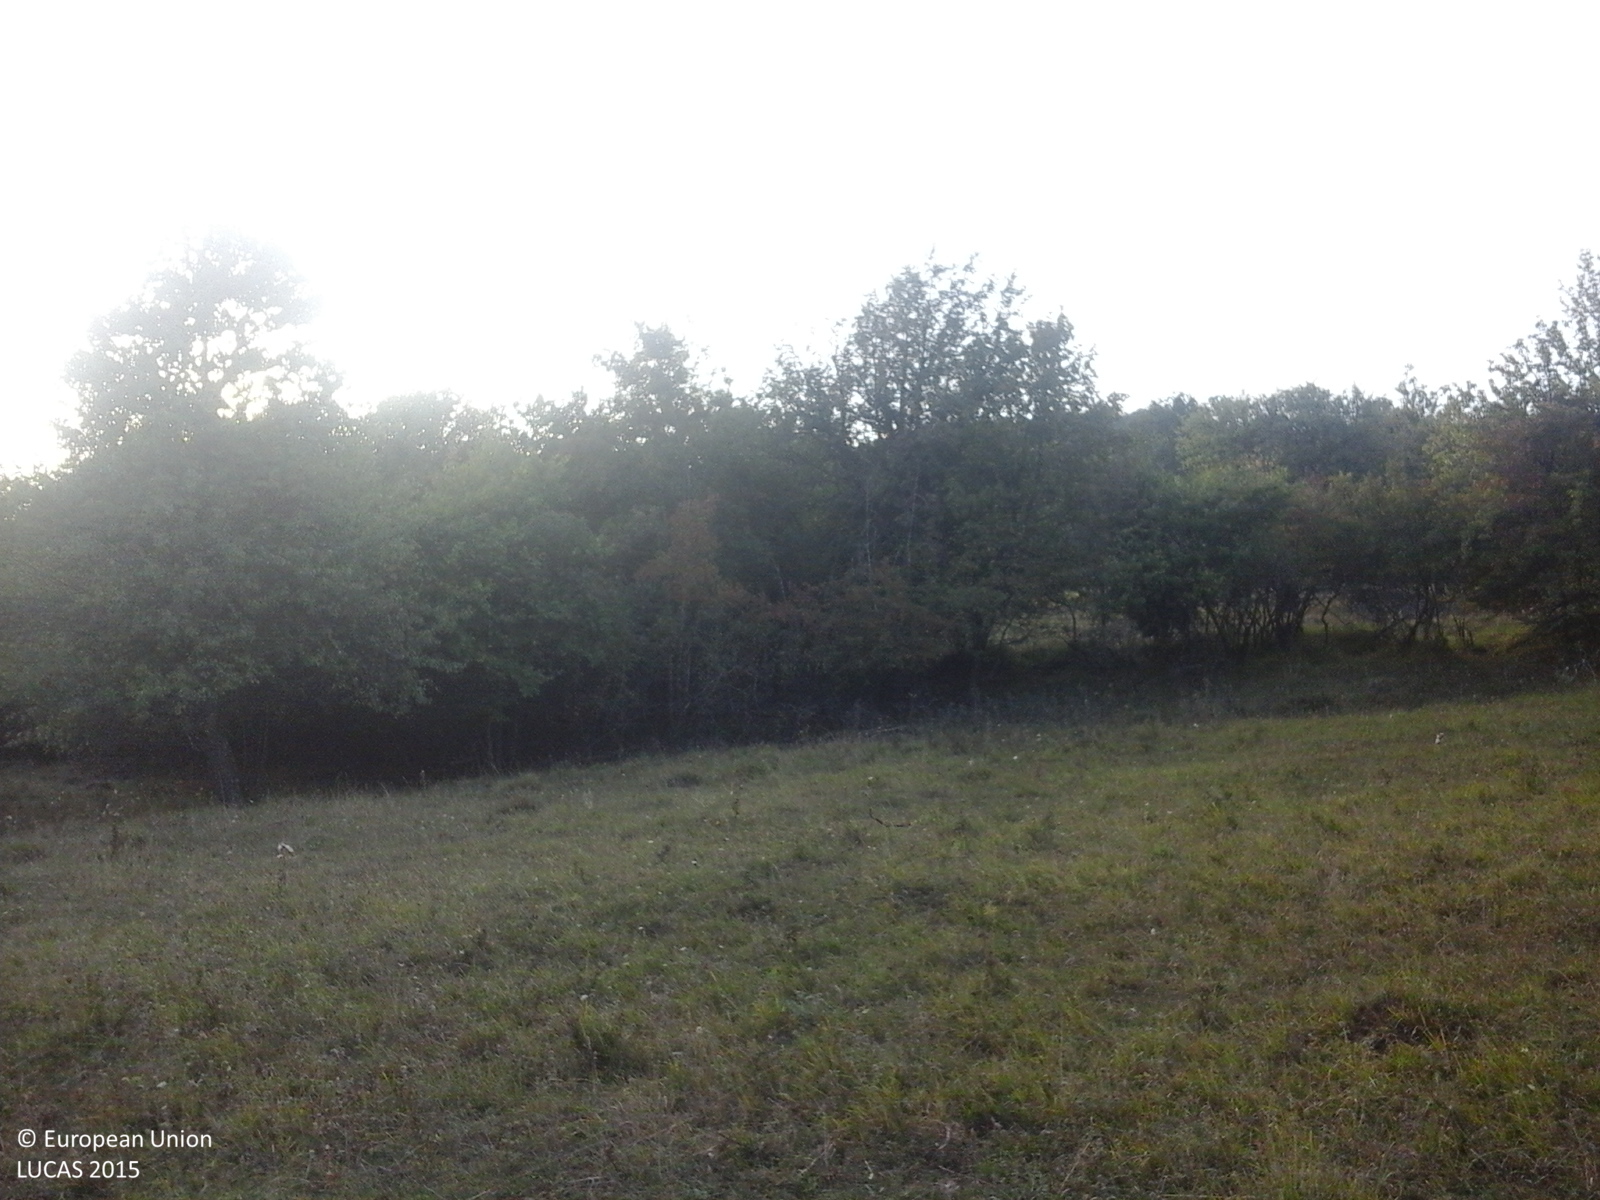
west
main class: Grassland
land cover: Grassland with sparse tree/shrub cover
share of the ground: > 75 %
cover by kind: herbaceous plants 85 %, shrubs 10 %, broadleaved forest trees 5 %
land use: Fallow land
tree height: < 5 m
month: September
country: RO
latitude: 46.8206
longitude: 23.0781
